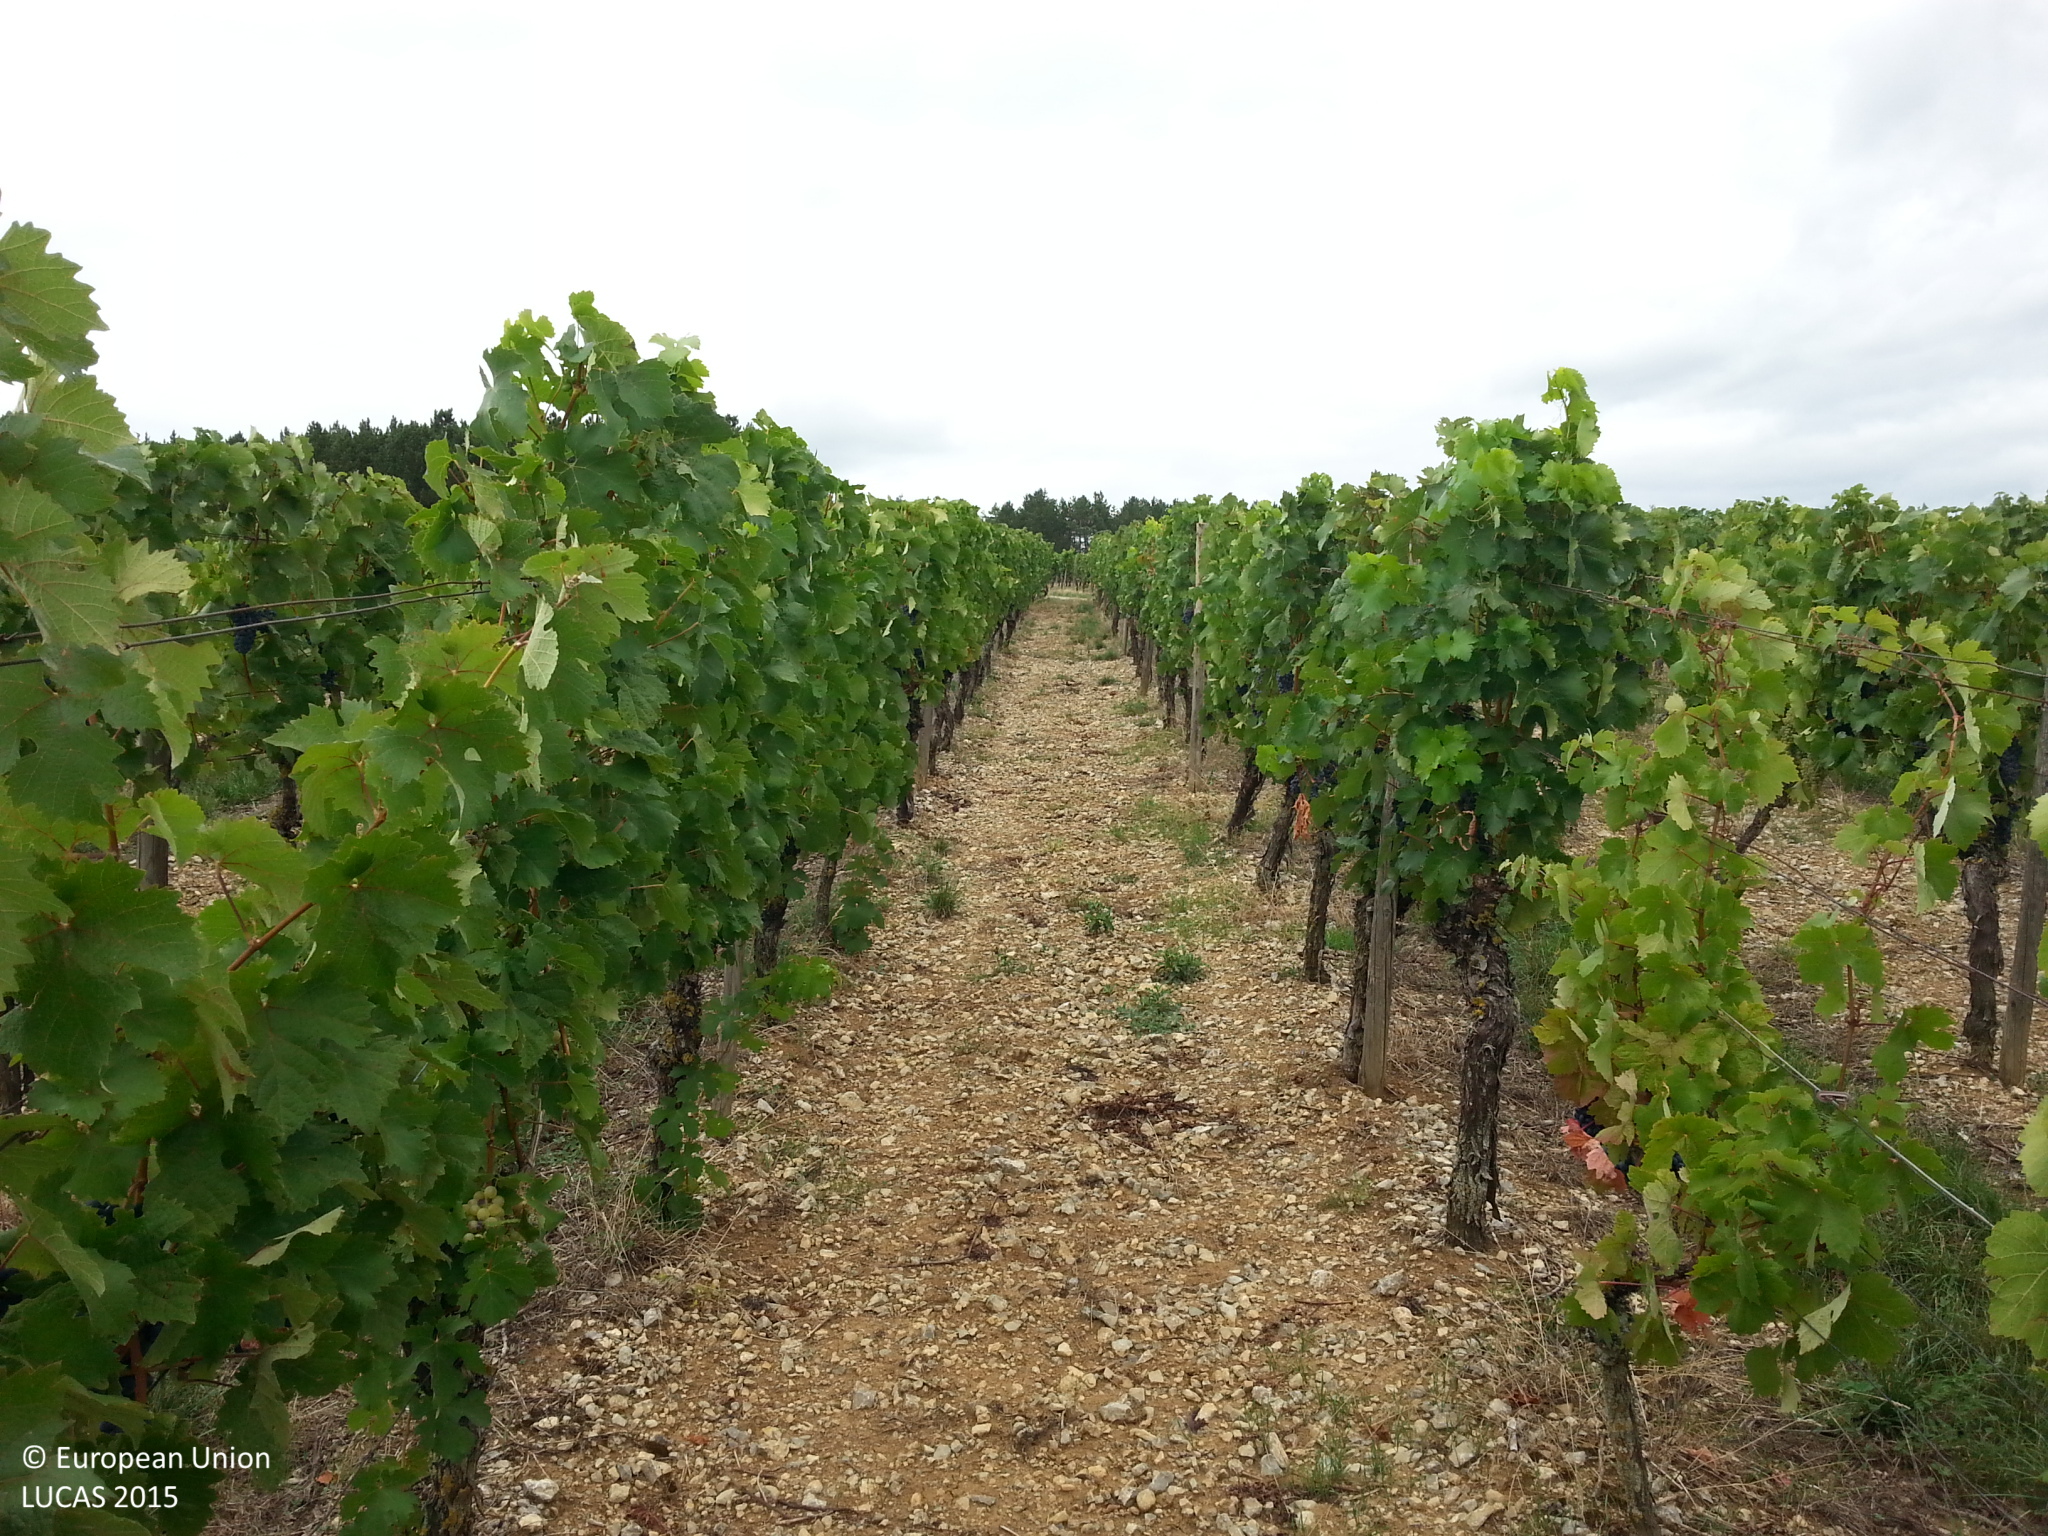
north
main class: Cropland
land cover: Vineyards
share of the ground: 50 - 75 %
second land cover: Spontaneously vegetated surfaces
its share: 10 - 25 %
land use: Agriculture (excluding fallow land and kitchen gardens)
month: September
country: DE
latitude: 49.6080
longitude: 9.5988
